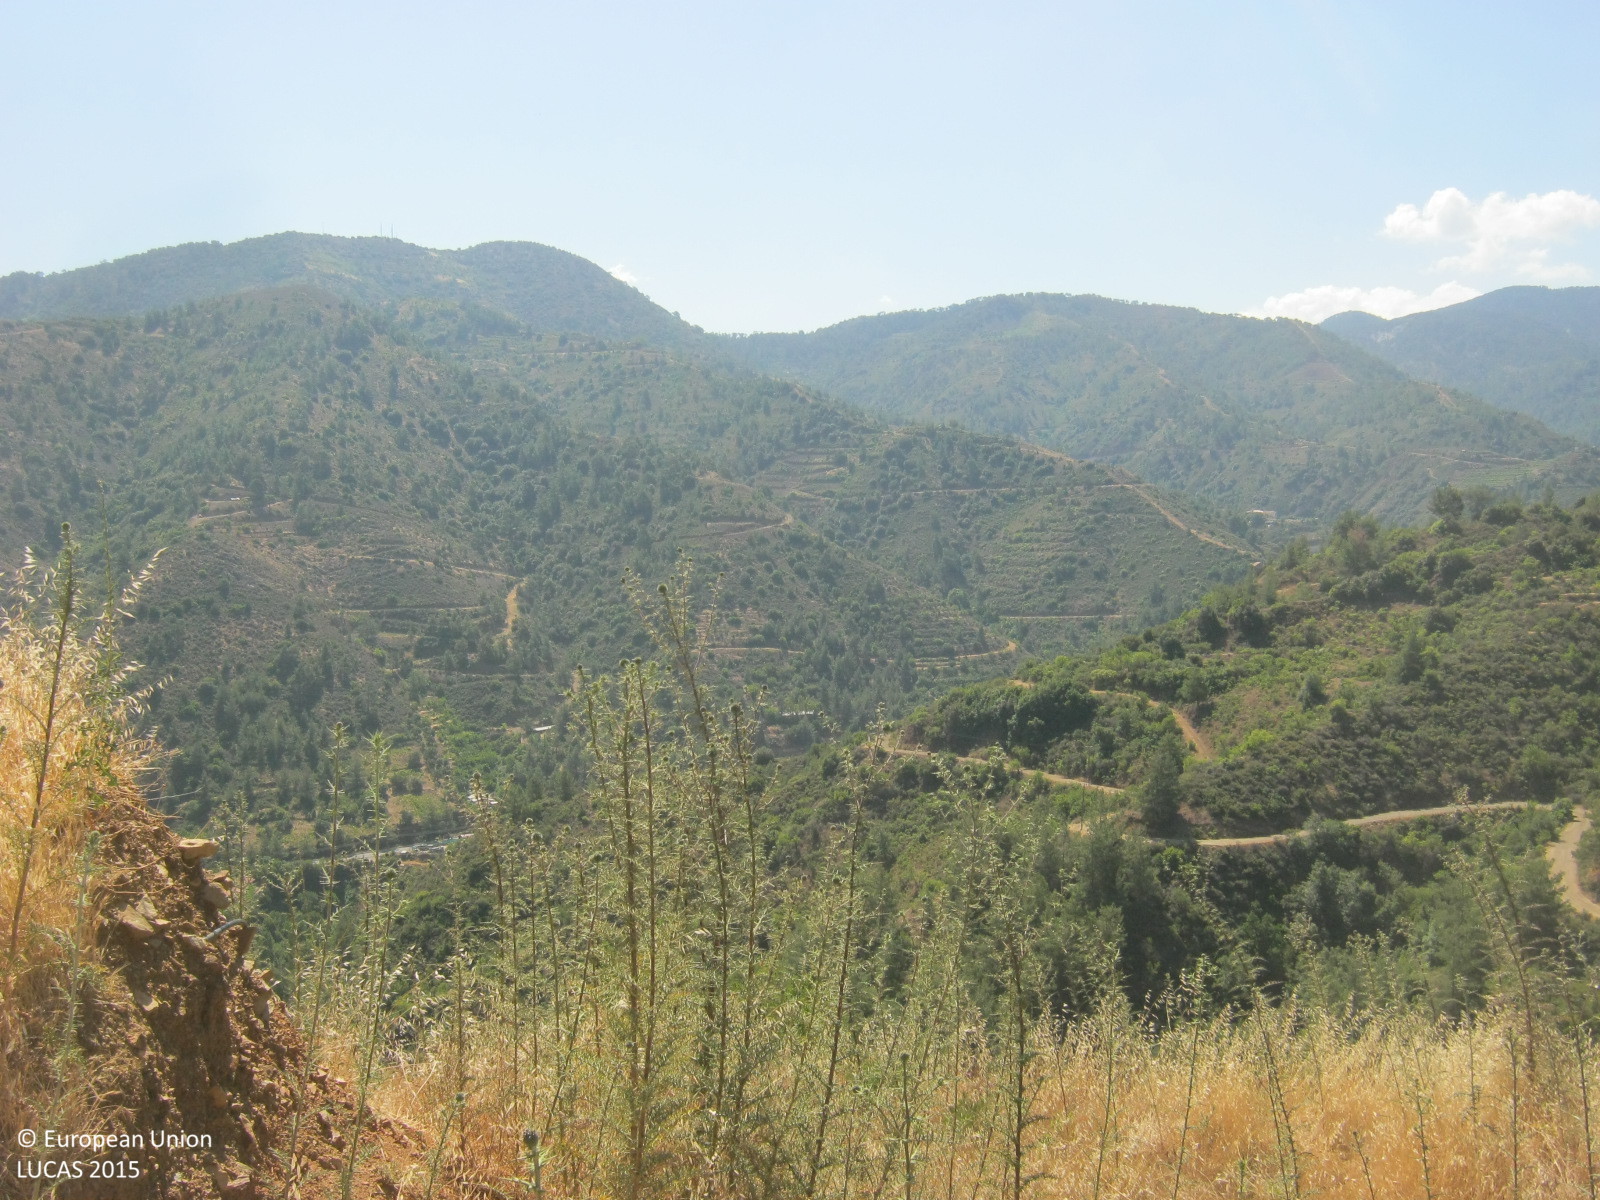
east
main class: Shrubland
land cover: Shrubland without tree cover
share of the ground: 25 - 50 %
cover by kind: herbaceous plants 60 %, shrubs 30 %, unconsolidated bare surface 10 %
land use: Semi-natural and natural areas not in use
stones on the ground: 25 - 50 %
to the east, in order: Shrubland without tree cover; Tracks; Grassland without tree/shrub cover; Tracks; Shrubland without tree cover; Tracks; Electric lines; Shrubland without tree cover; Fences; Shrubland without tree cover; Olive groves; Fences; Shrubland without tree cover; Shrubland with sparse tree cover
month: June
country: CY
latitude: 35.0092
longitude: 32.8173
